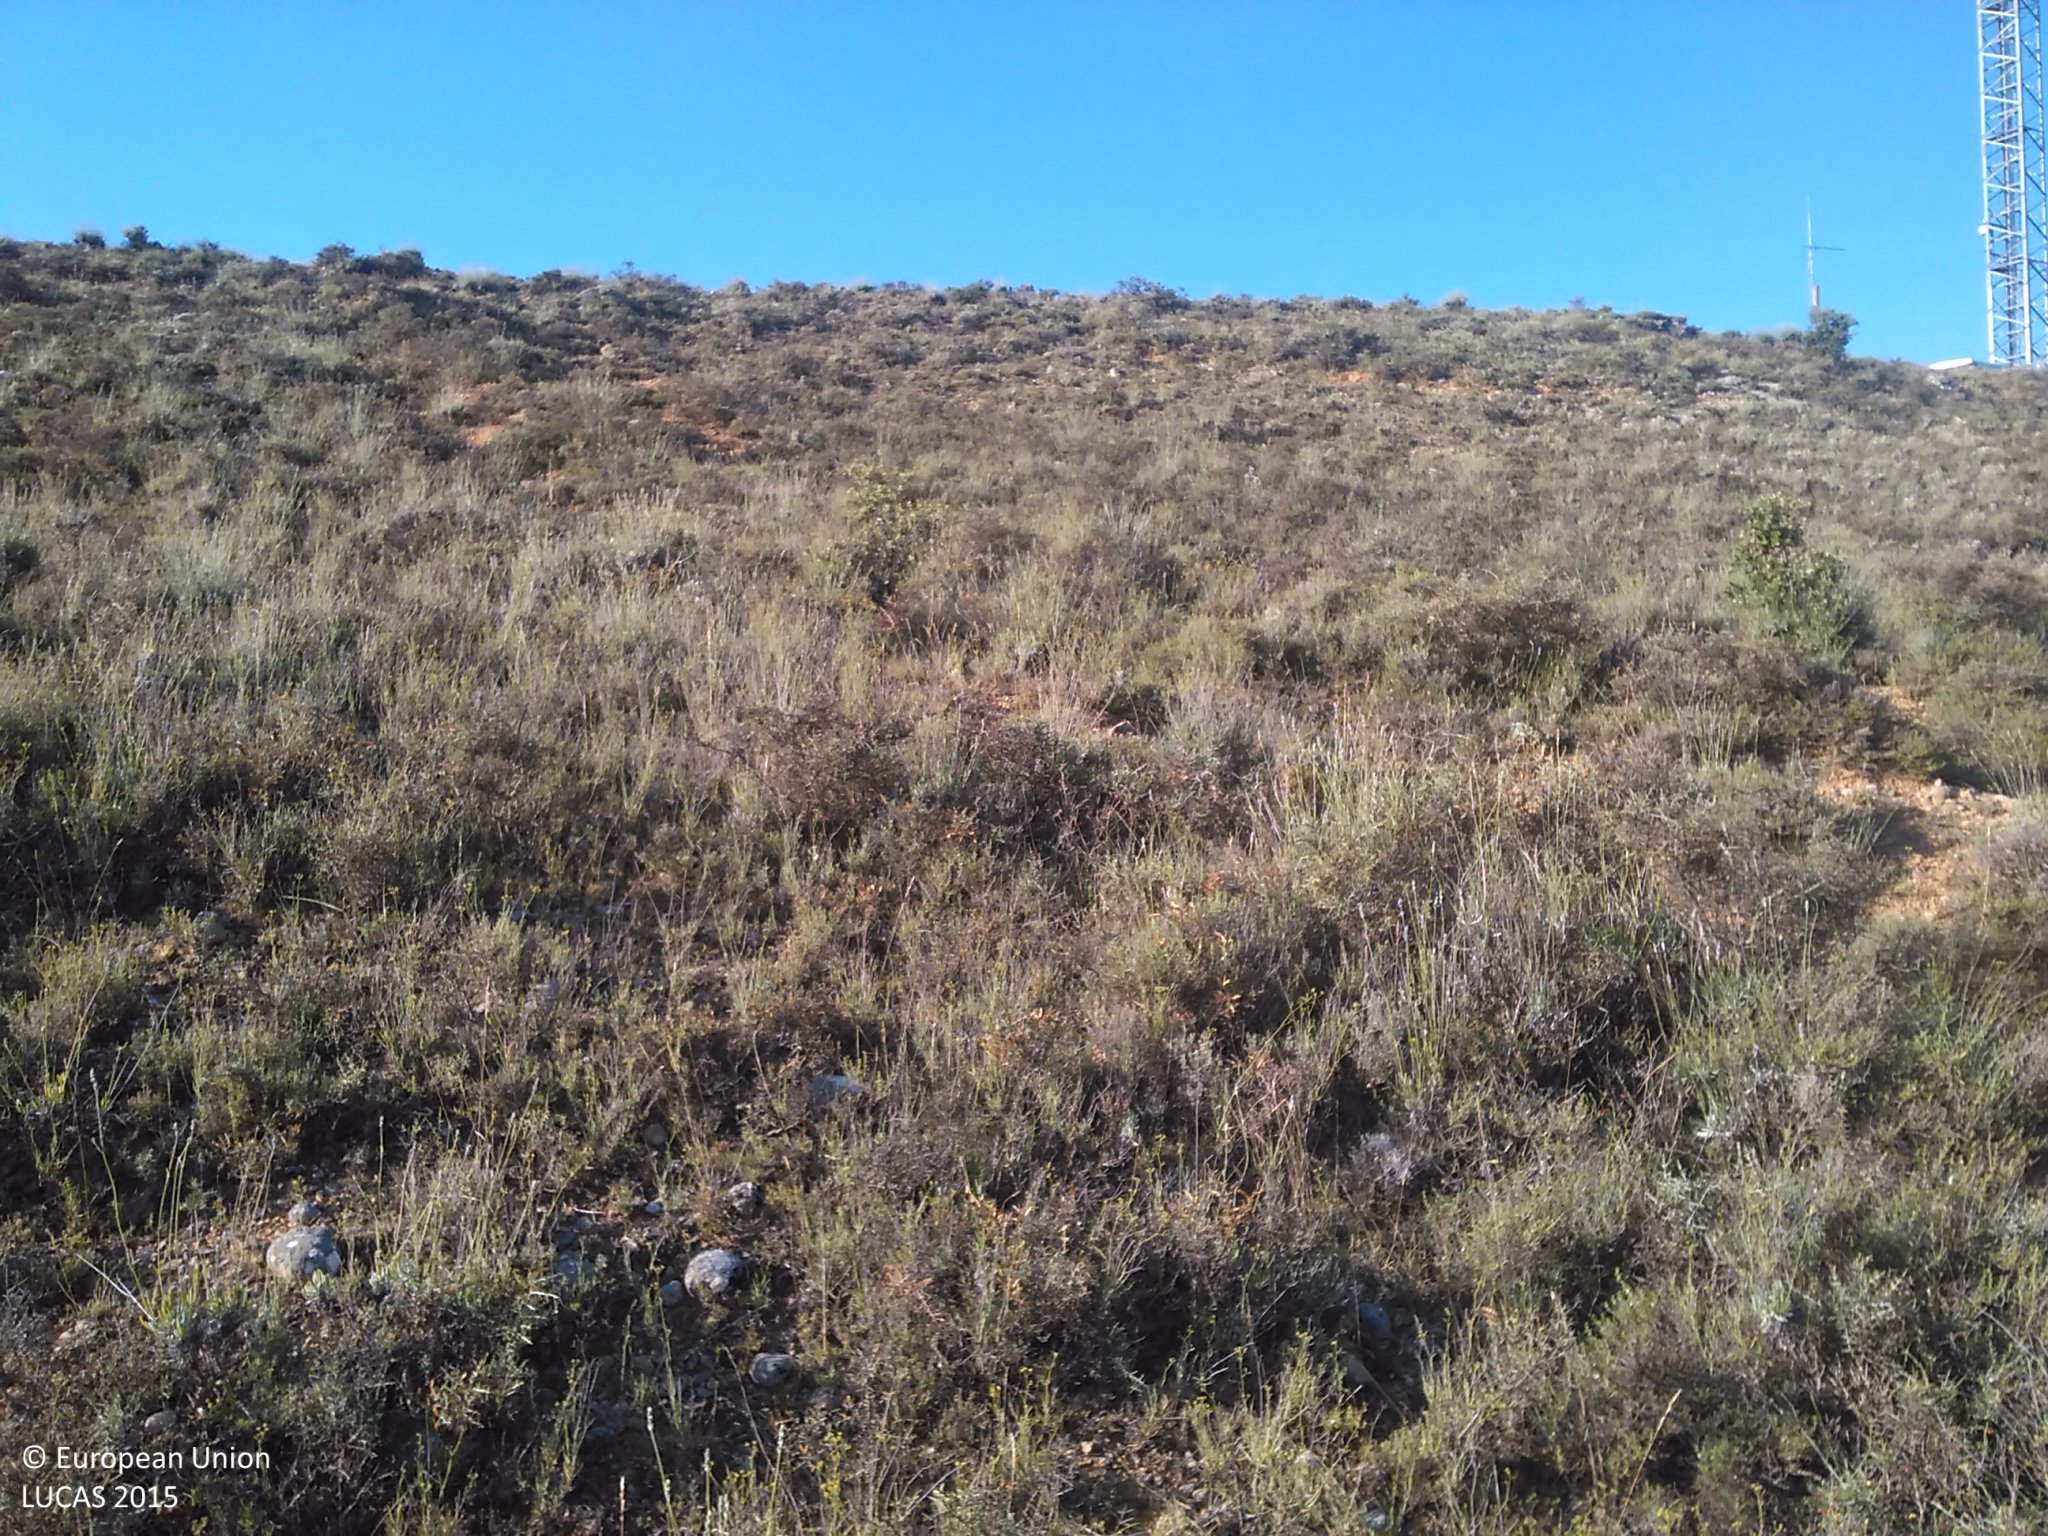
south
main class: Shrubland
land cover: Shrubland without tree cover
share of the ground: 50 - 75 %
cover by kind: shrubs 70 %, unconsolidated bare surface 30 %
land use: Semi-natural and natural areas not in use
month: July
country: ES
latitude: 41.4950
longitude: -2.1903
